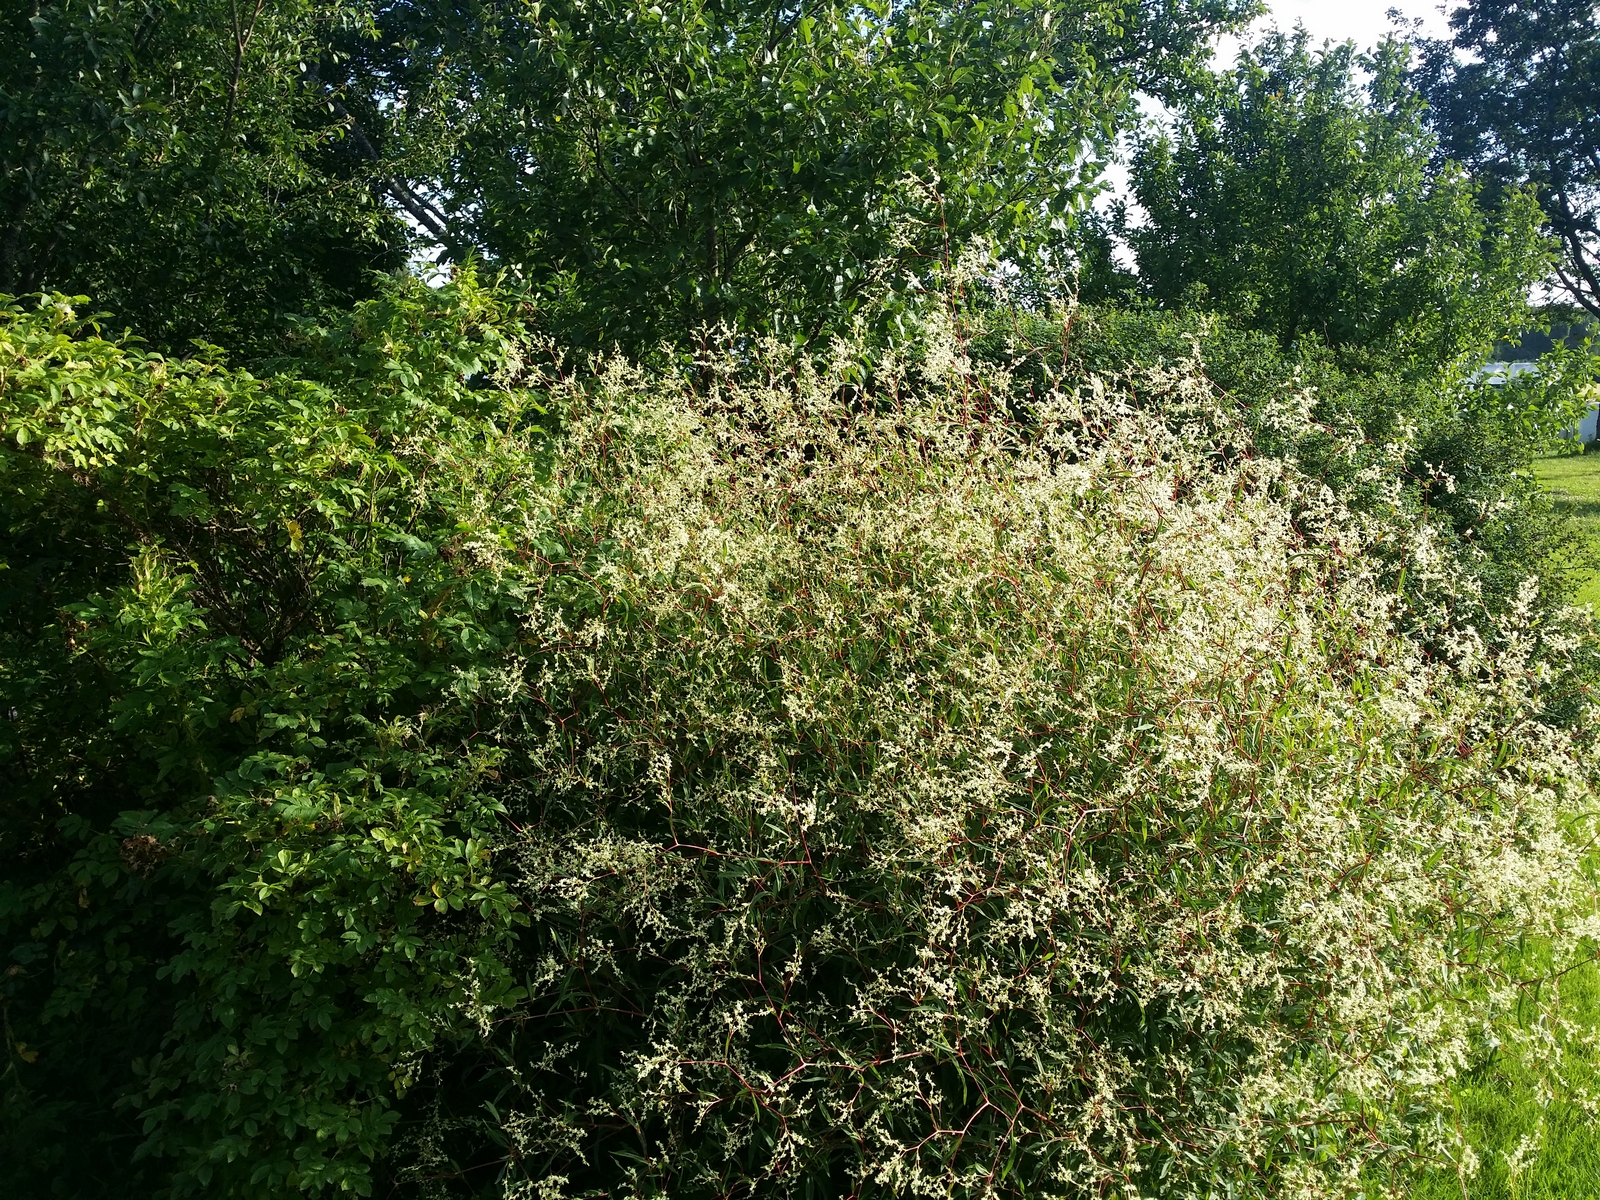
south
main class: Grassland
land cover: Grassland without tree/shrub cover
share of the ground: > 75 %
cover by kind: herbaceous plants 100 %
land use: Residential
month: July
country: LV
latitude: 57.1818
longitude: 27.2572
